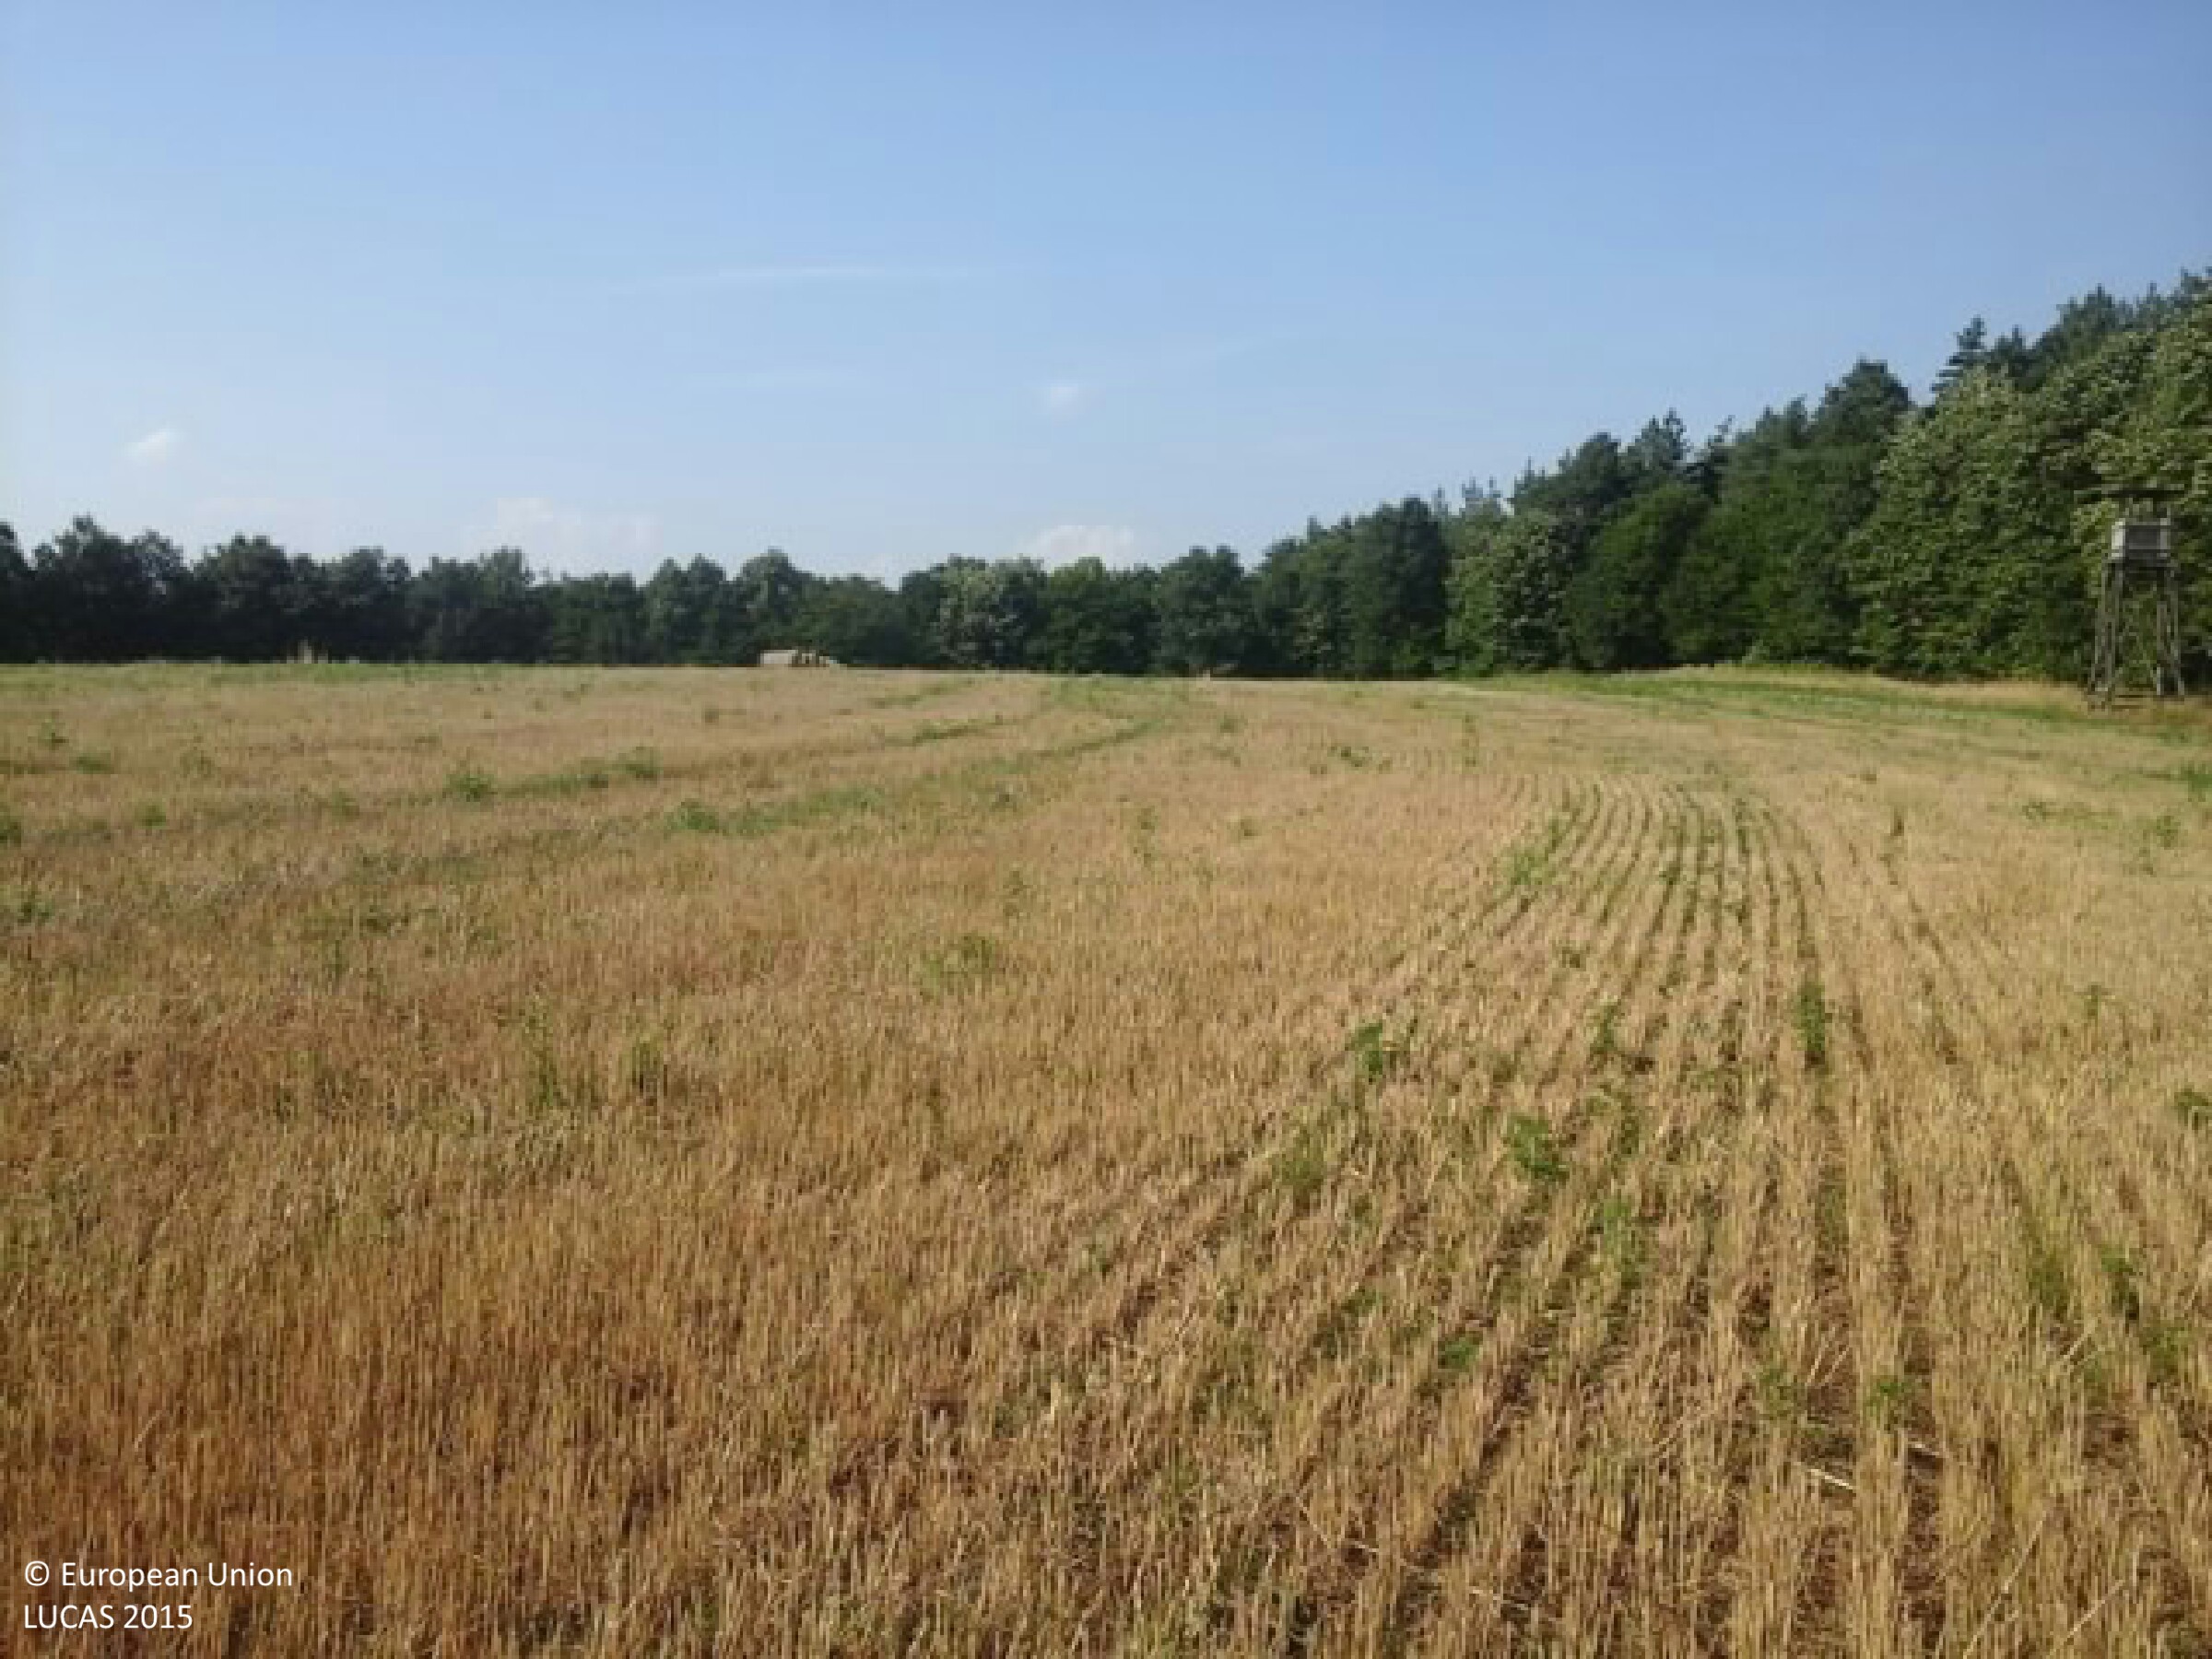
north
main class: Cropland
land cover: Triticale
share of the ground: < 10 %
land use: Agriculture (excluding fallow land and kitchen gardens)
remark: Harvested field
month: August
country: HU
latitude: 46.2854
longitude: 18.0150
